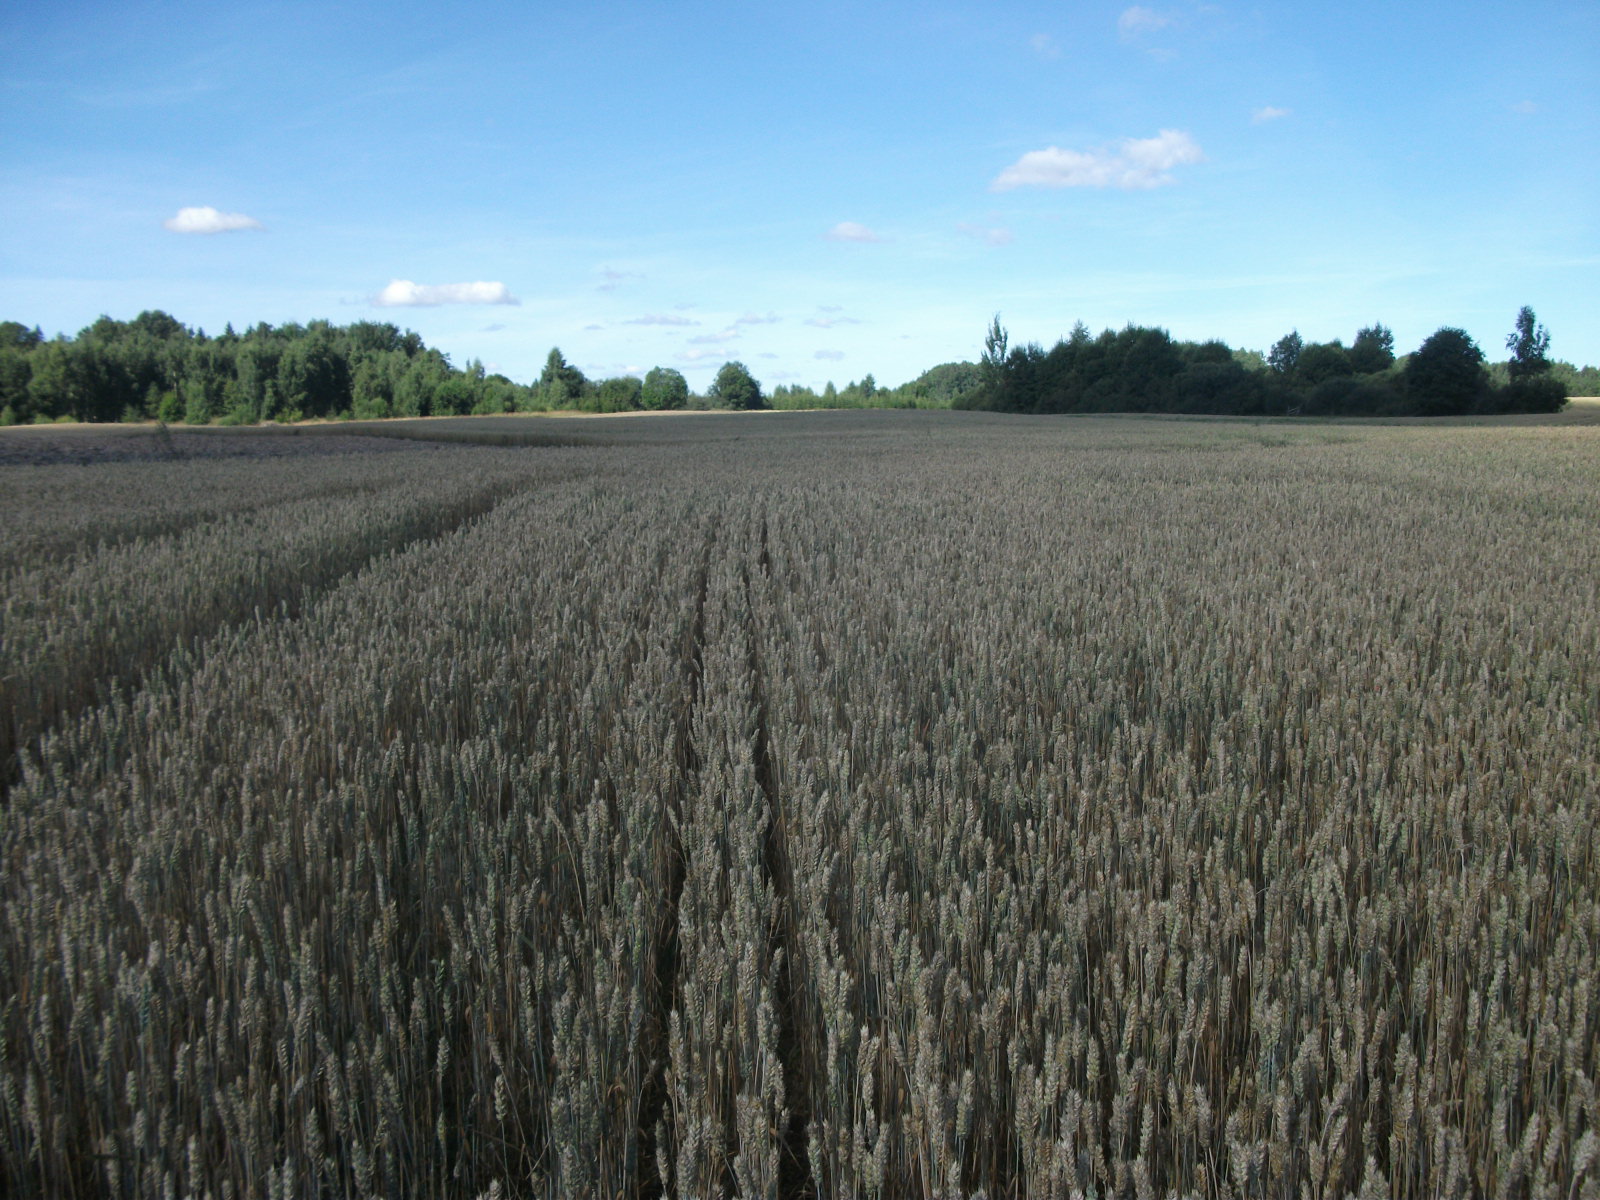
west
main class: Cropland
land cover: Common wheat
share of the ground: > 75 %
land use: Agriculture (excluding fallow land and kitchen gardens)
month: August
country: LV
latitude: 56.6994
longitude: 26.2924
